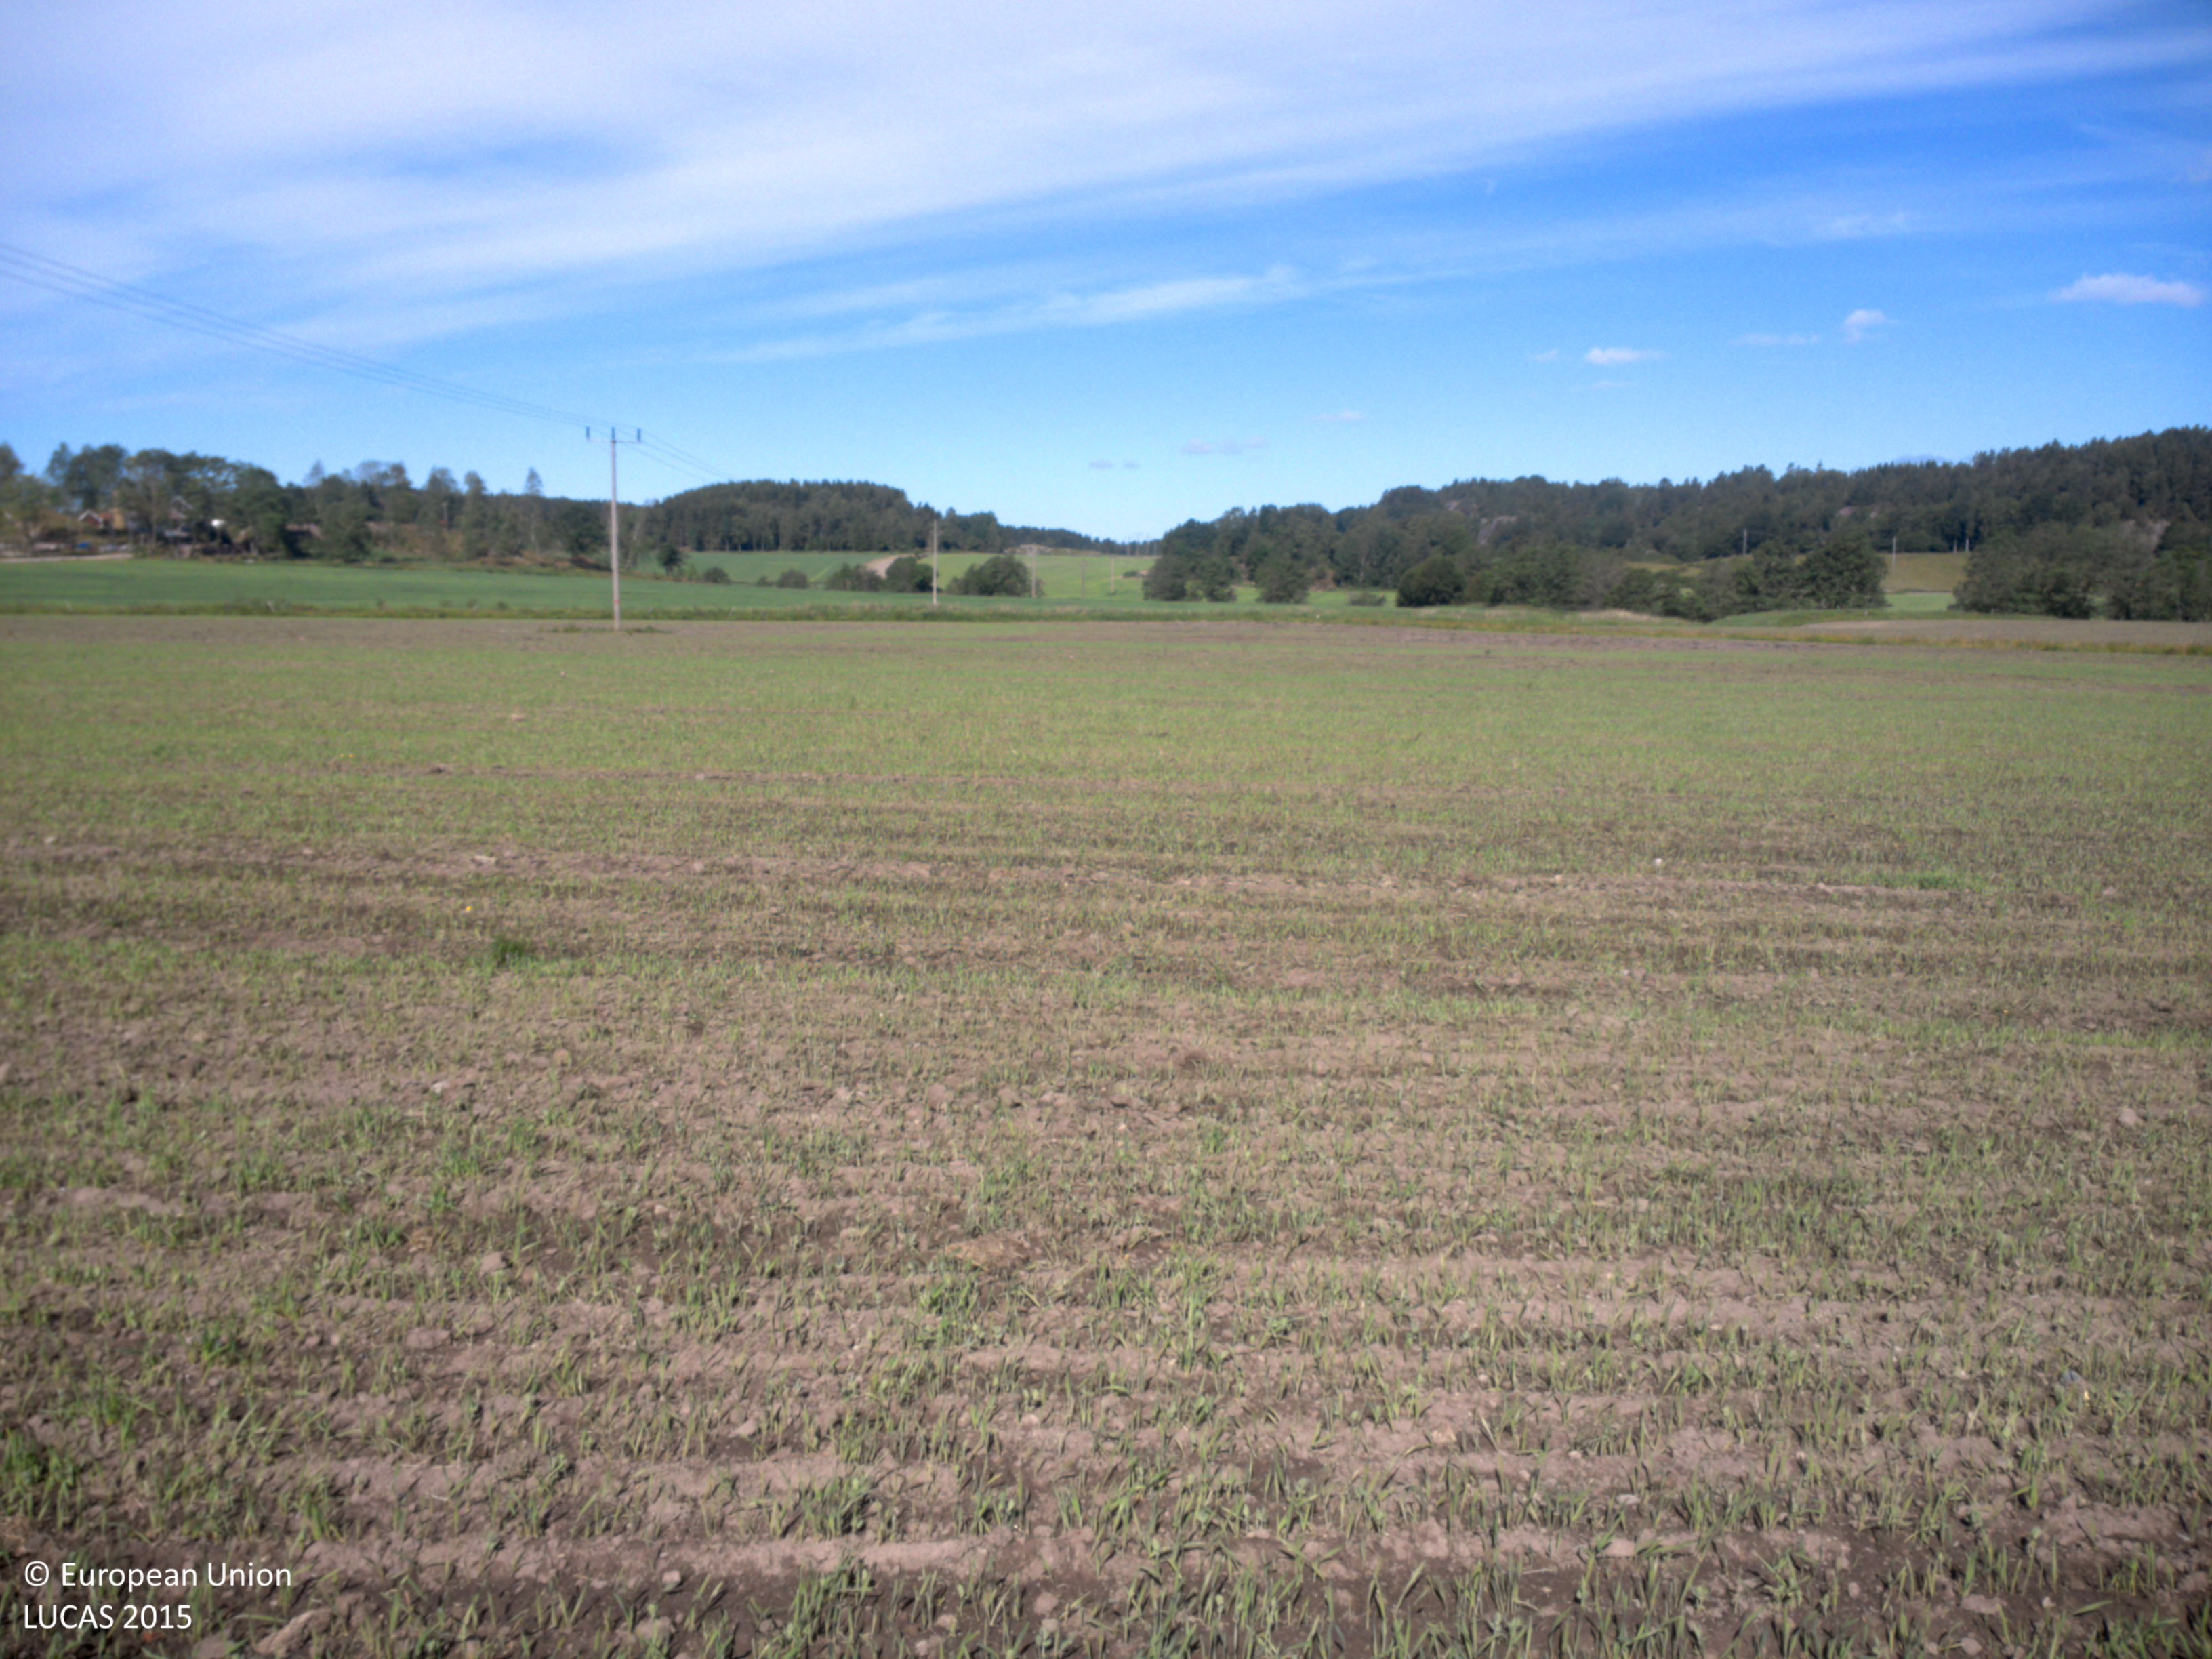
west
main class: Cropland
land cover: Common wheat
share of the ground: 50 - 75 %
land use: Agriculture (excluding fallow land and kitchen gardens)
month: June
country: SE
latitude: 58.4795
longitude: 11.6257
